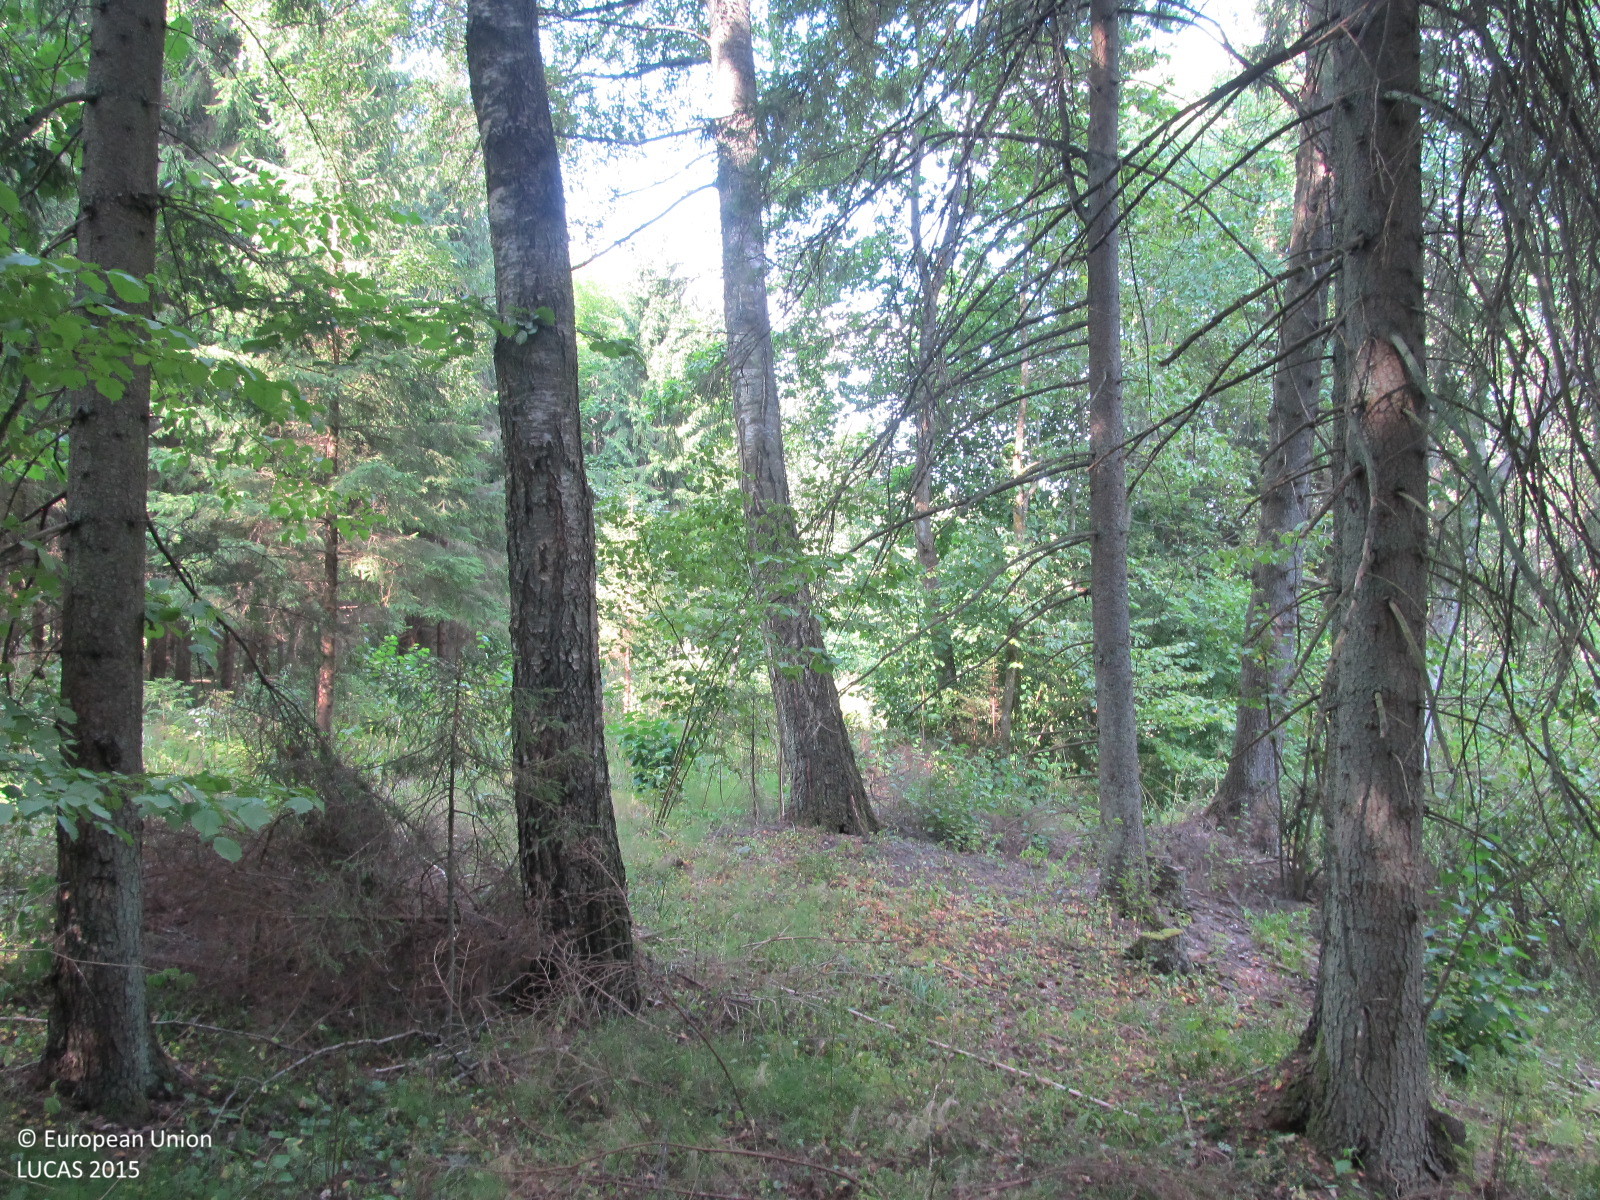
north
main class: Woodland
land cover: Spruce dominated mixed woodland
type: hemiboreal forest and nemoral coniferous forest and mixed broadleaved-coniferous forest
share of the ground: 50 - 75 %
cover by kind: coniferous forest trees 45 %, broadleaved forest trees 25 %, herbaceous plants 20 %, shrubs 10 %
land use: Forestry
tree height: > 5 m
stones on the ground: < 10 %
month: August
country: LT
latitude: 55.7574
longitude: 23.0243
